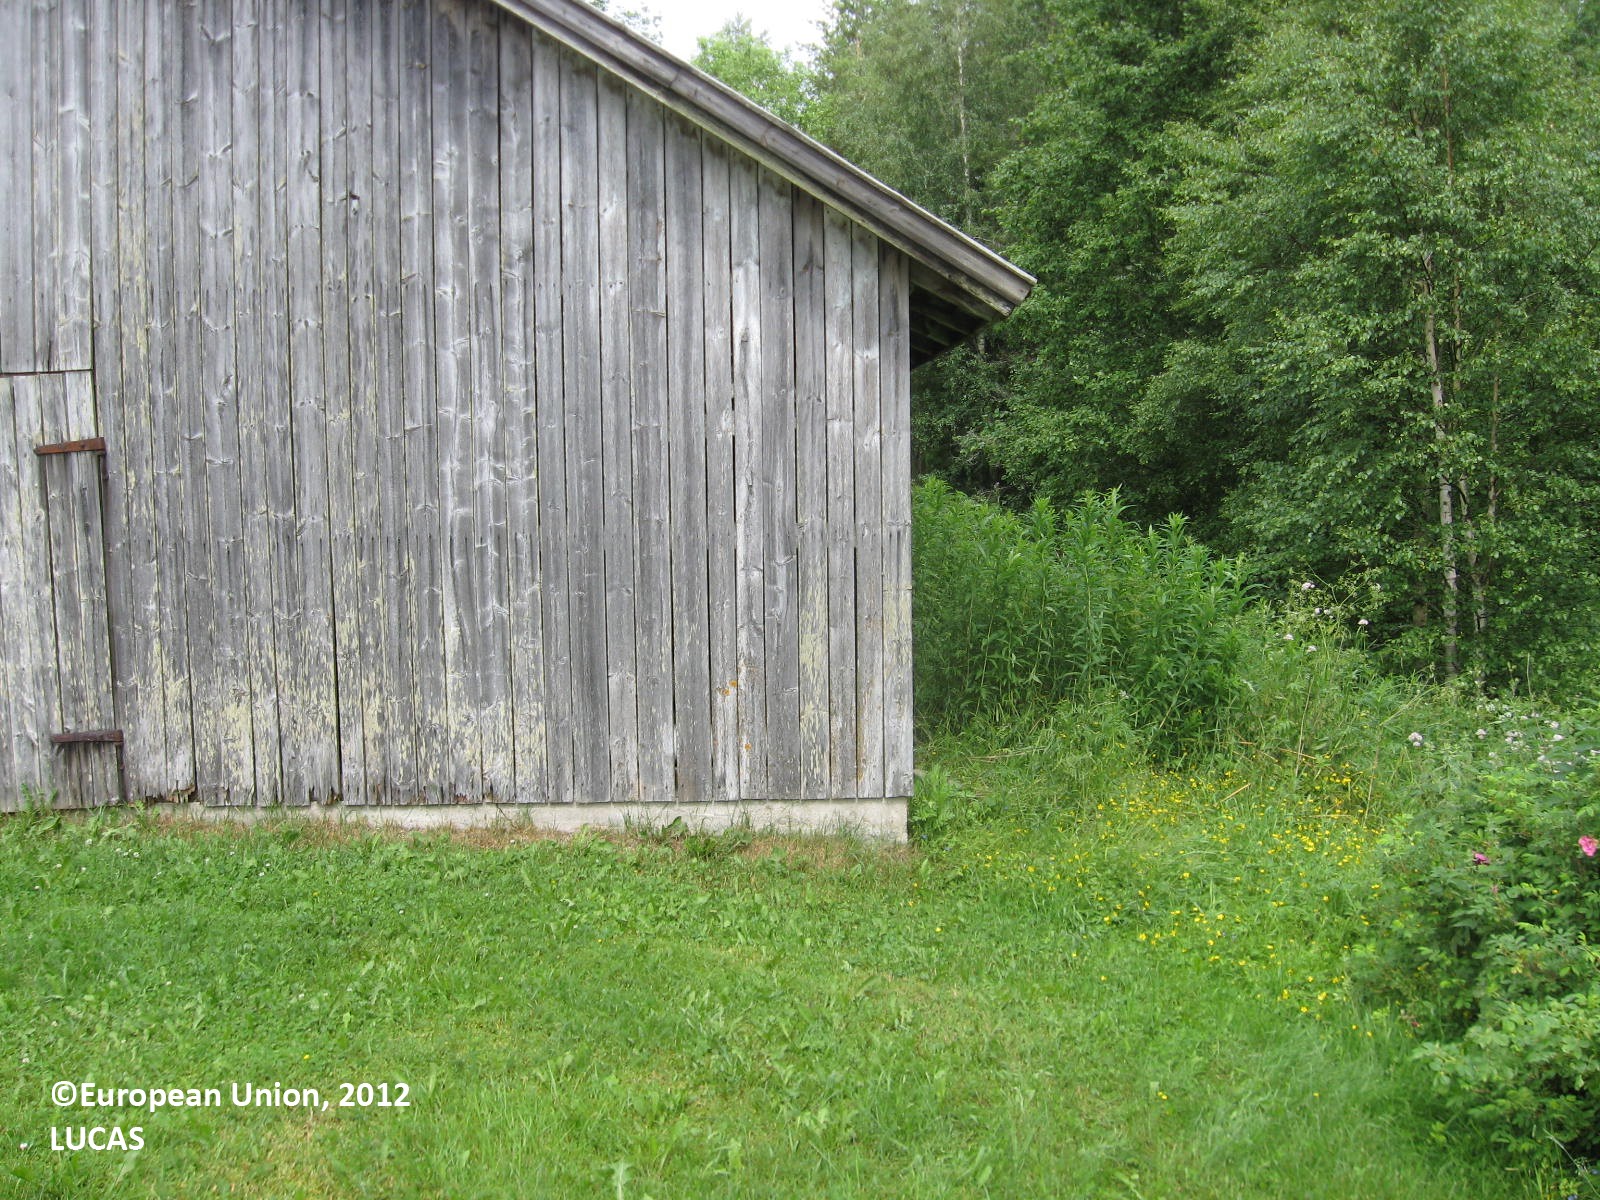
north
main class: Grassland
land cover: Grassland with sparse tree/shrub cover
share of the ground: > 75 %
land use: Residential
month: July
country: FI
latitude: 62.4212
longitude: 22.4666
